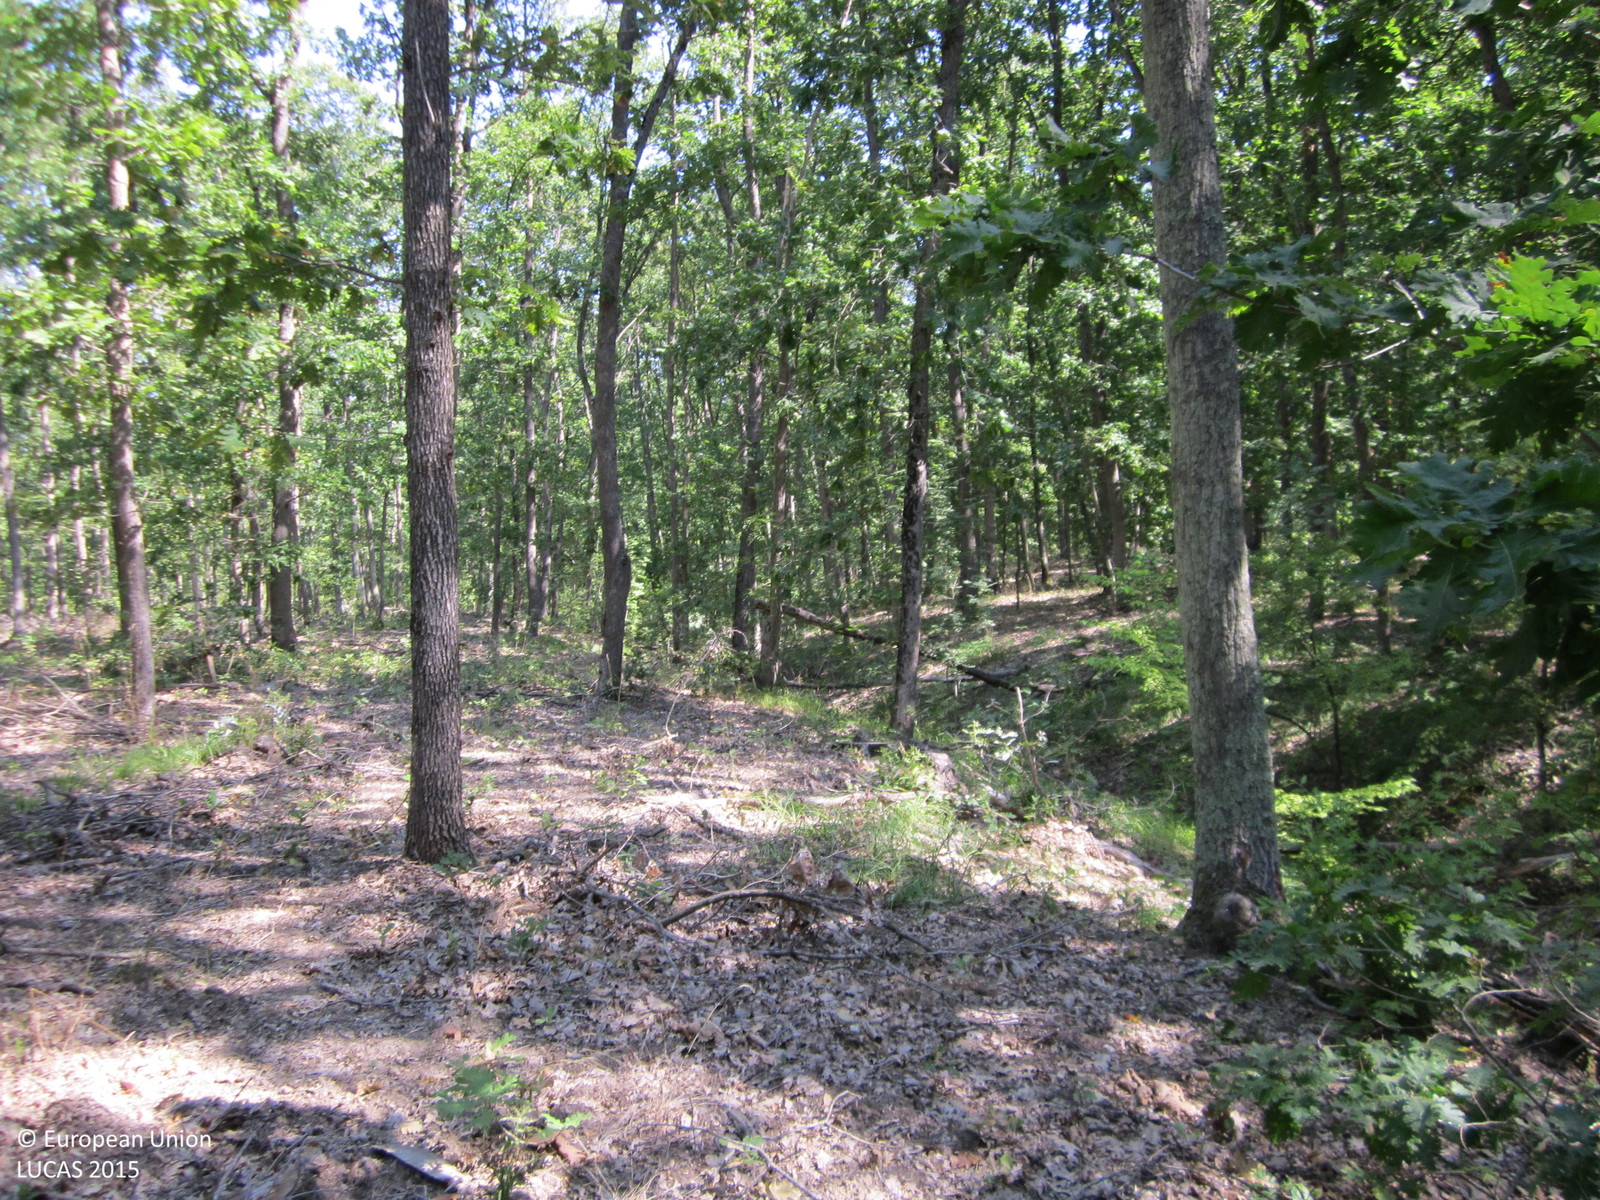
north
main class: Woodland
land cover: Broadleaved woodland
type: thermophilous deciduous forest
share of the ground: > 75 %
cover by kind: broadleaved forest trees 95 %, unconsolidated bare surface 5 %
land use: Forestry
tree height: > 5 m
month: August
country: BG
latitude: 42.8709
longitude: 27.7951
